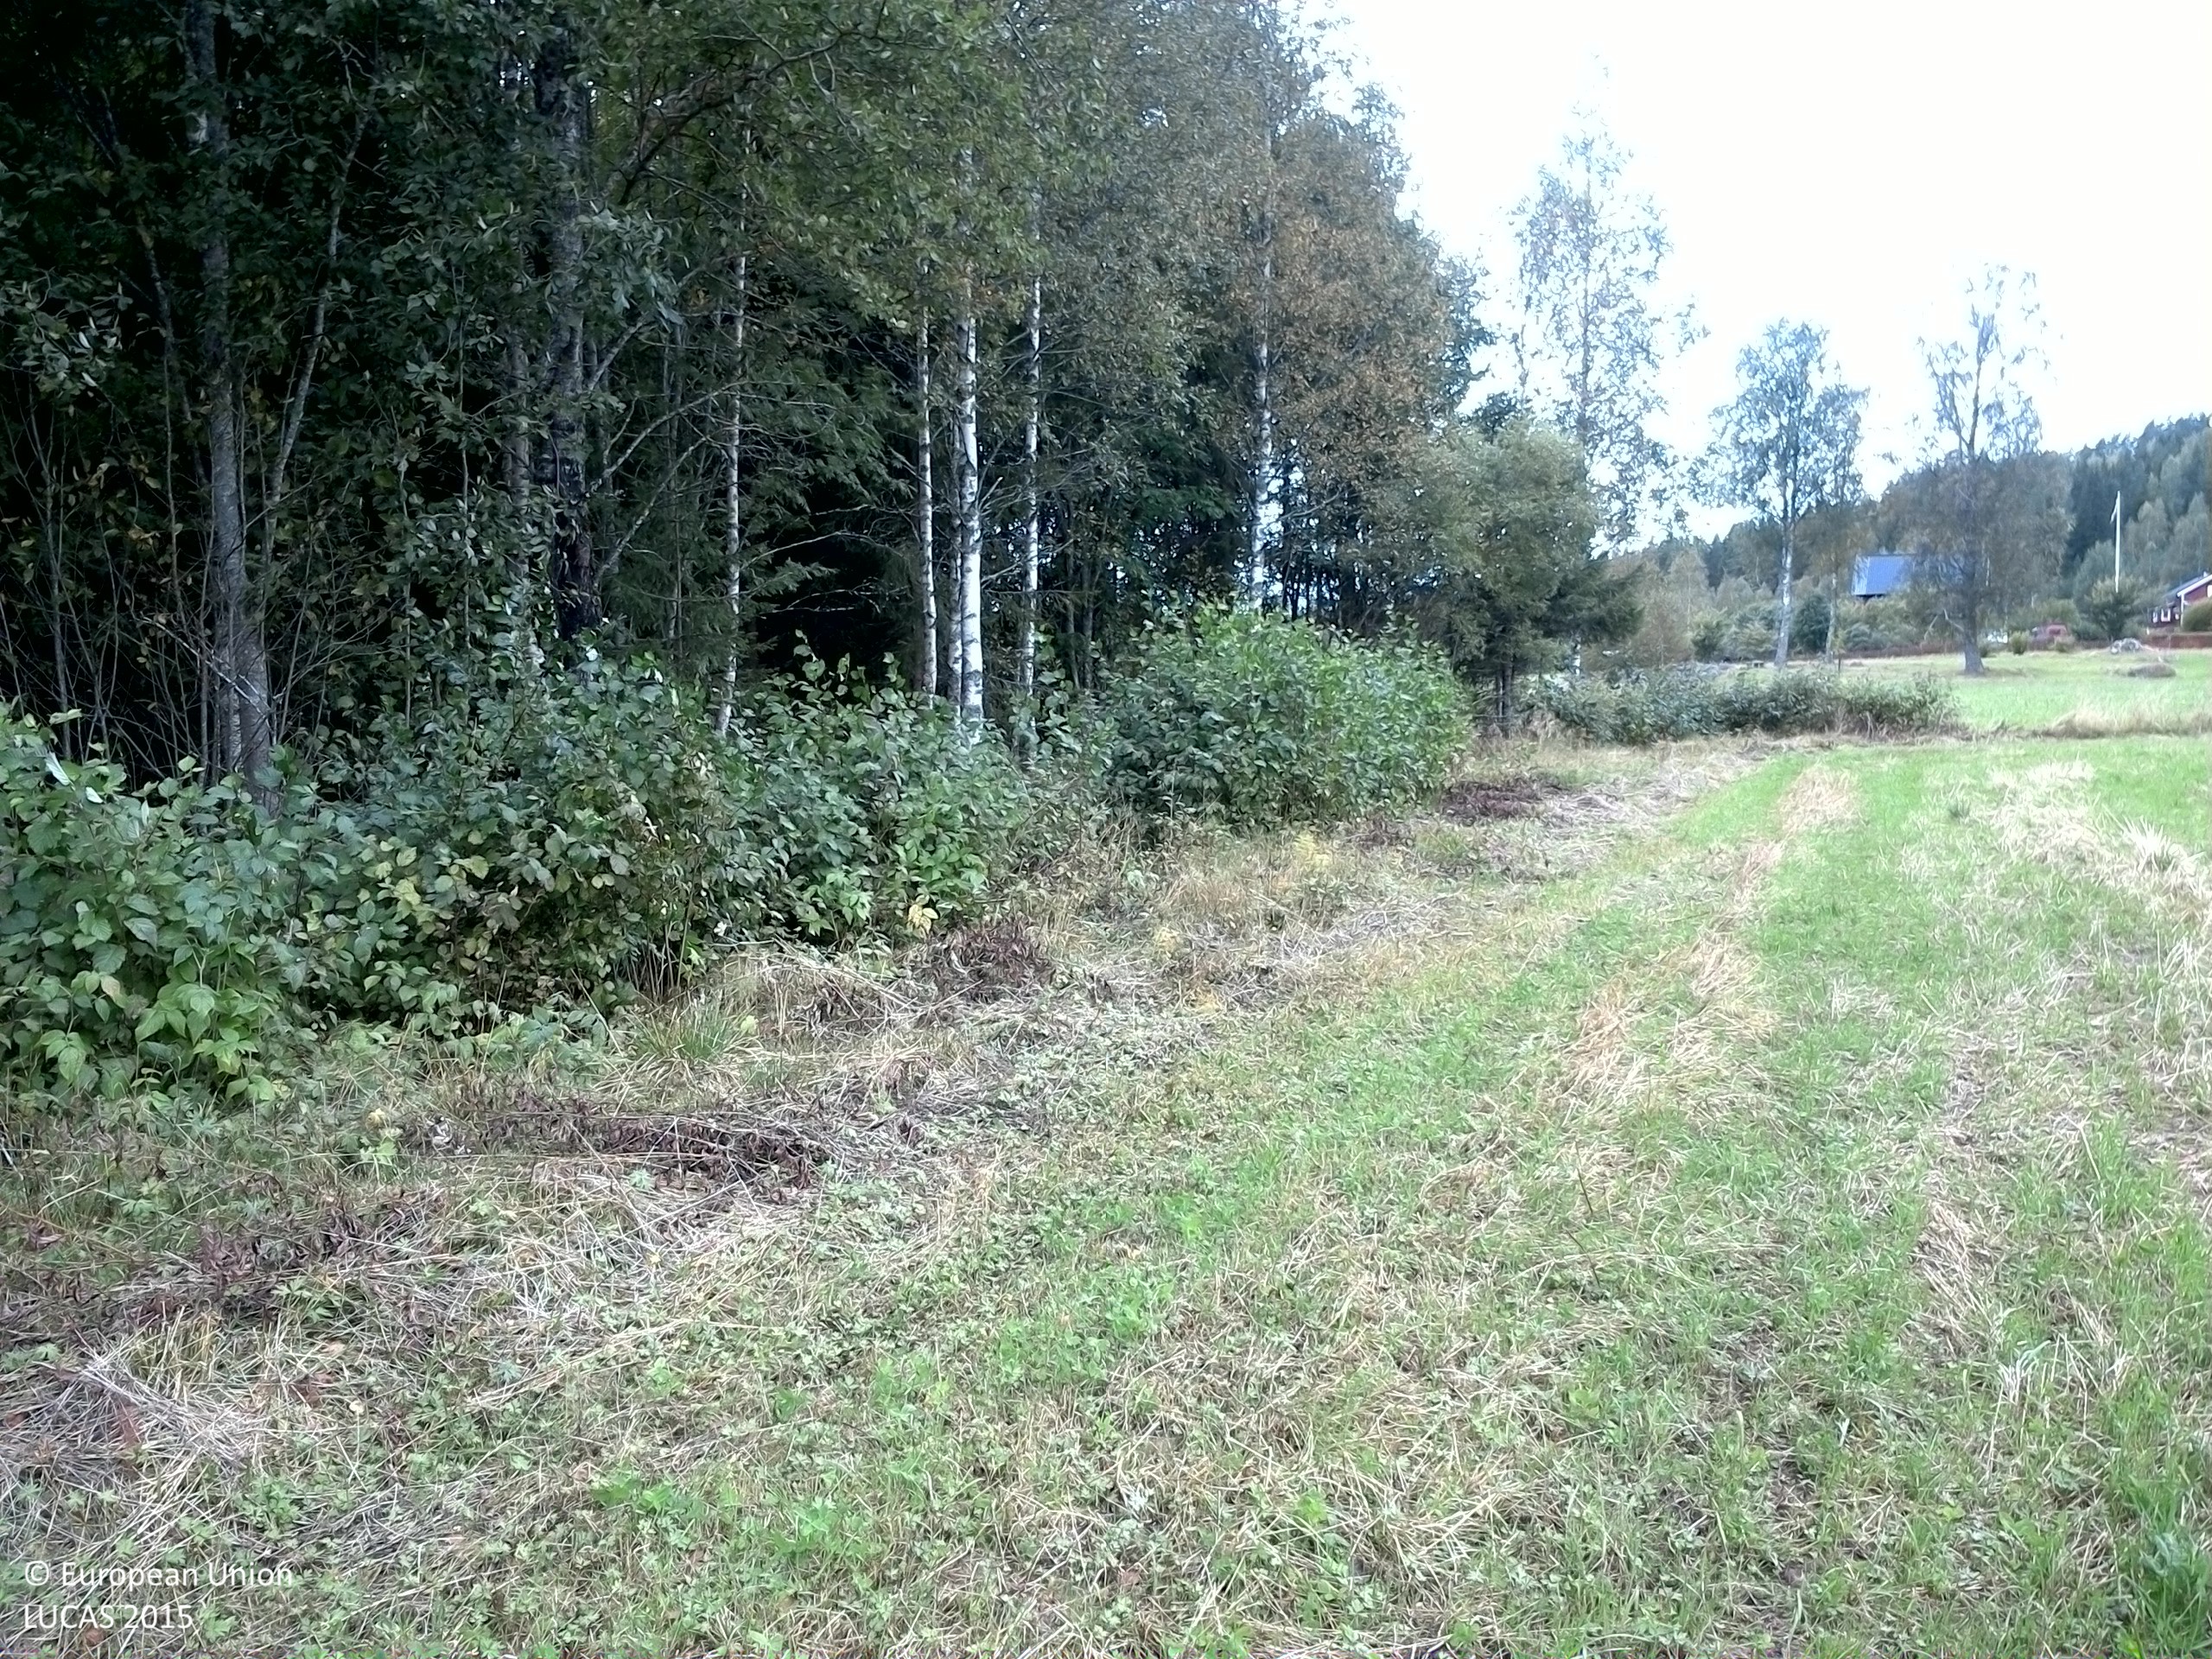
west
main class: Grassland
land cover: Grassland without tree/shrub cover
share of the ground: > 75 %
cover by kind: herbaceous plants 90 %, consolidated bare surface 10 %
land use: Agriculture (excluding fallow land and kitchen gardens)
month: September
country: SE
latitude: 59.8317
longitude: 13.4700
